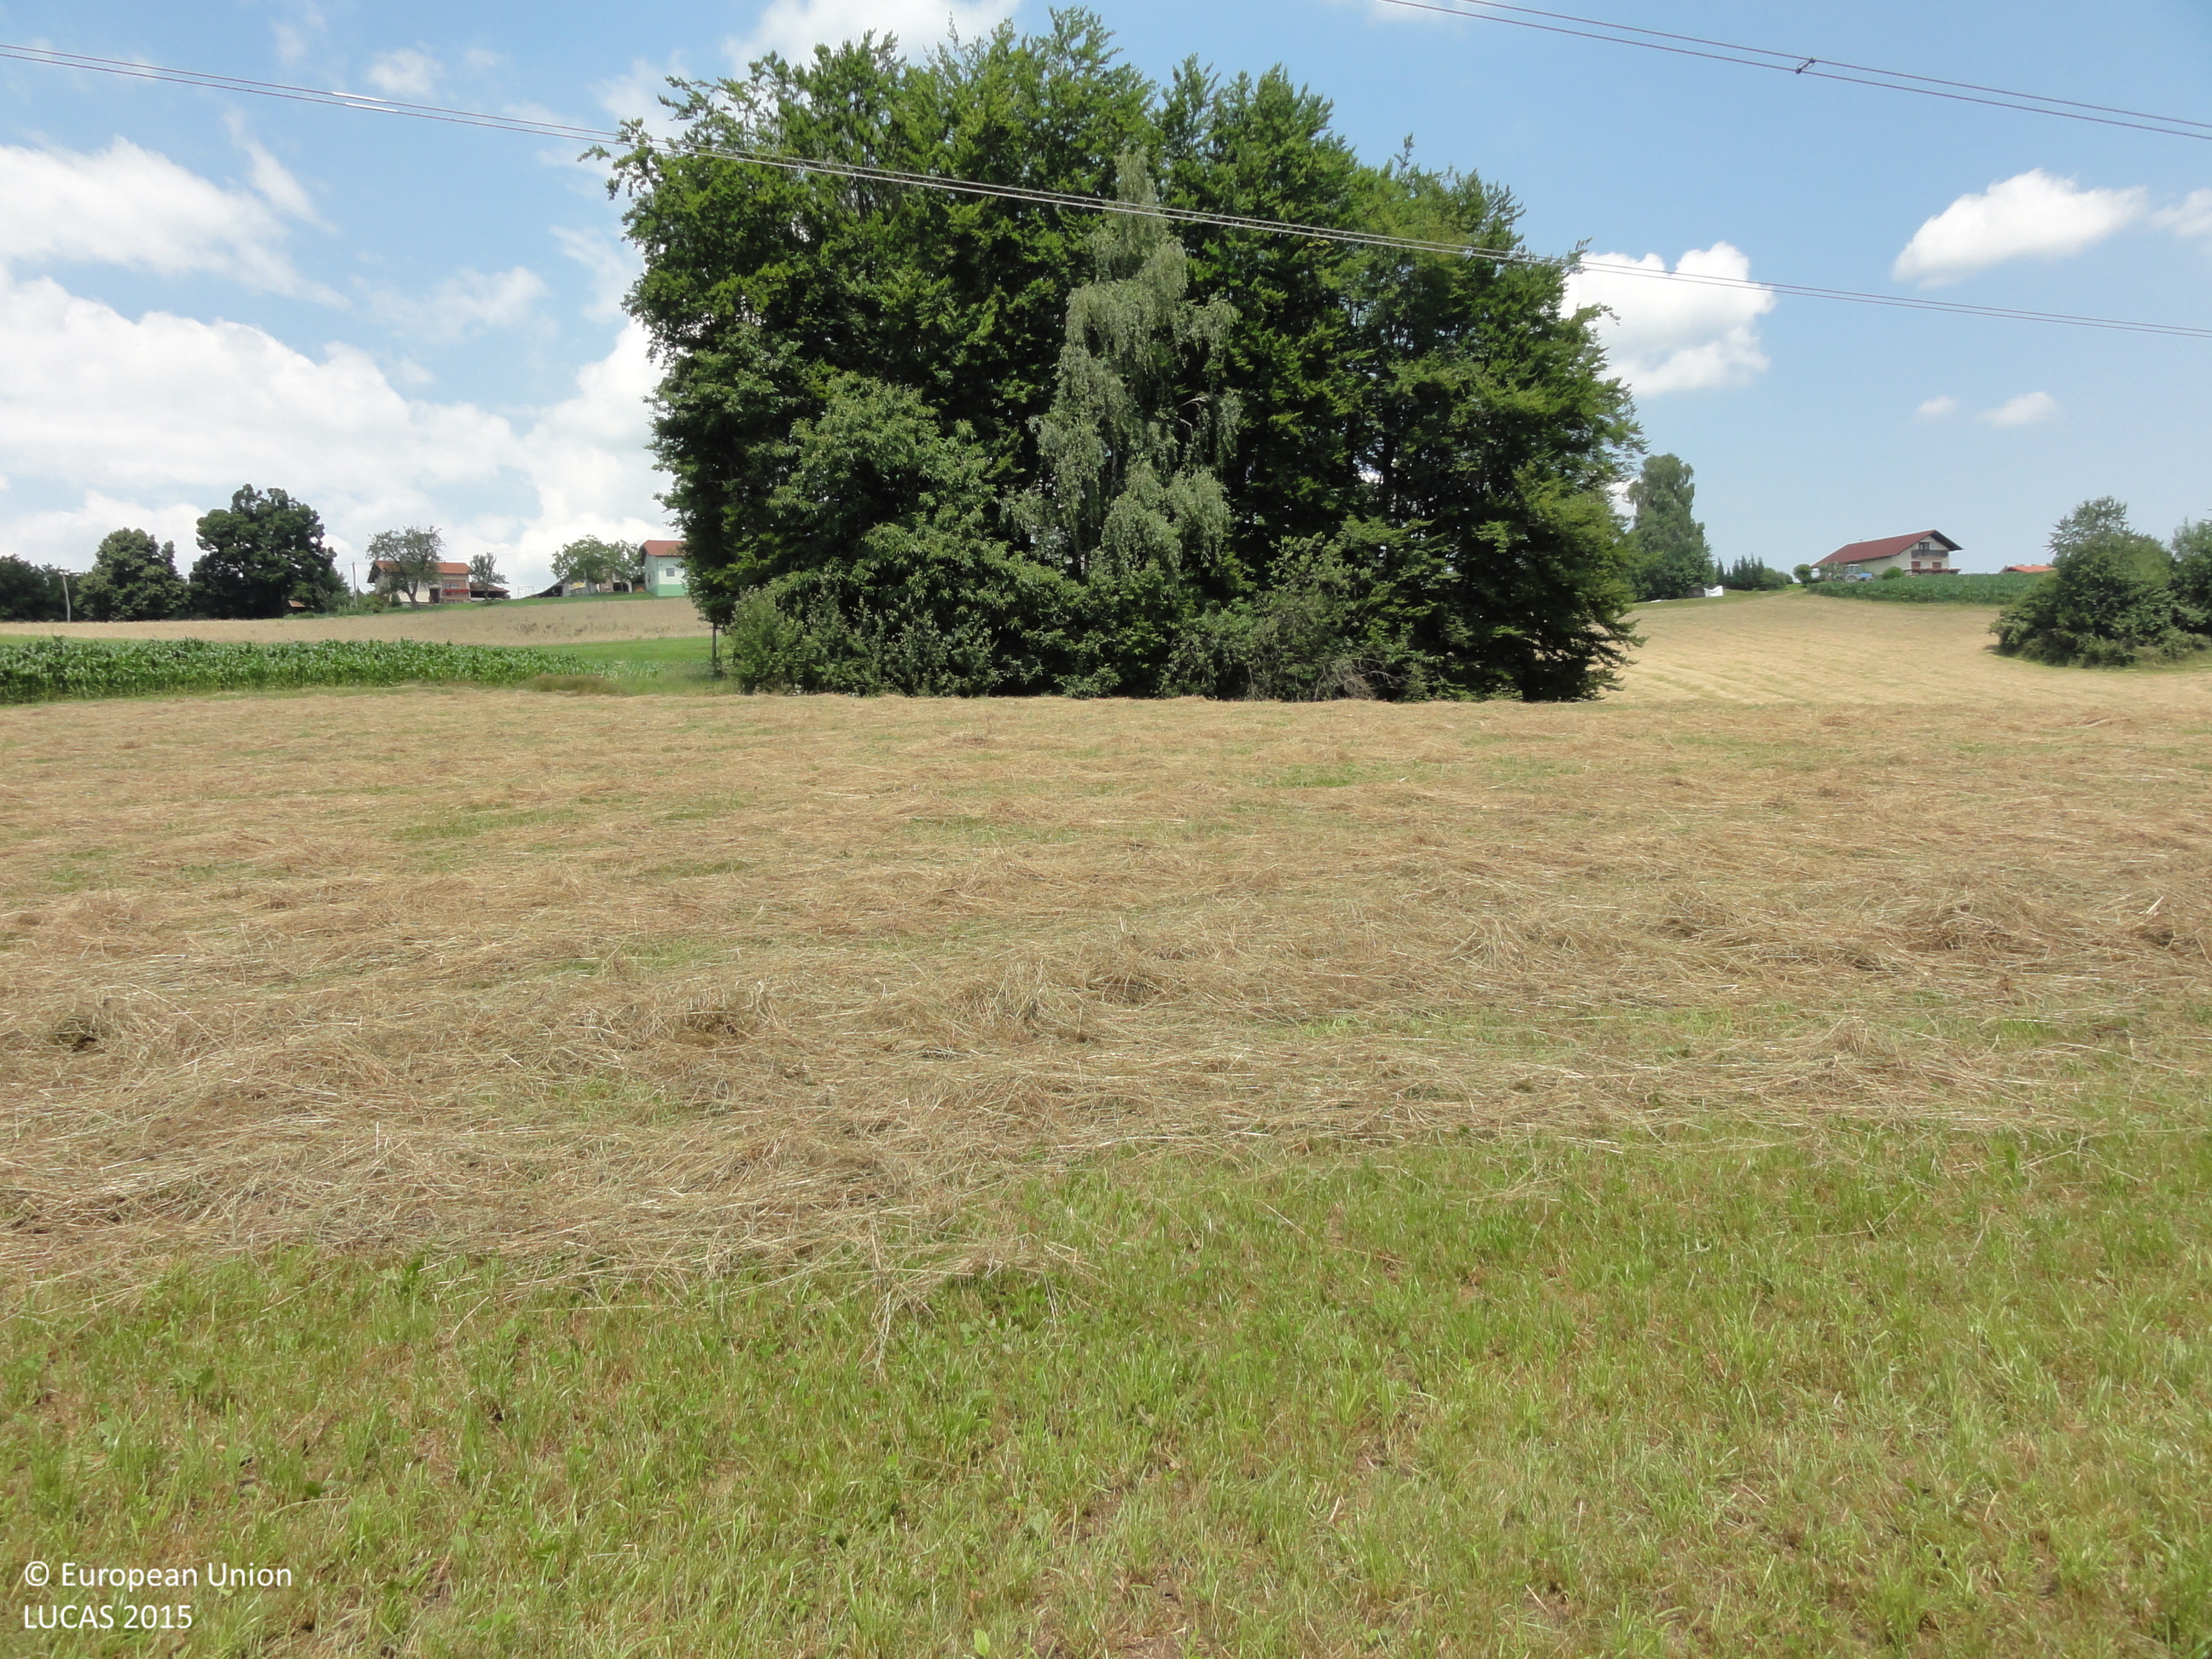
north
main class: Grassland
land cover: Grassland without tree/shrub cover
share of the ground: > 75 %
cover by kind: herbaceous plants 100 %
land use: Agriculture (excluding fallow land and kitchen gardens)
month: July
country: SI
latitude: 46.3351
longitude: 15.5195
